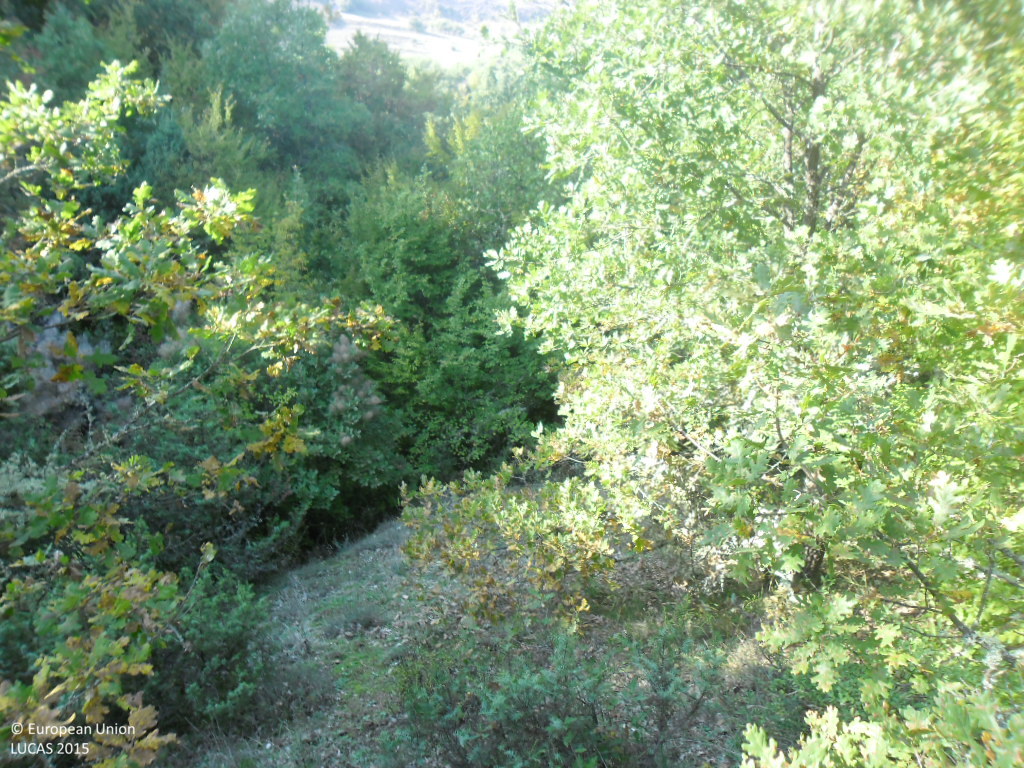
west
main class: Woodland
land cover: Broadleaved woodland
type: hemiboreal forest and nemoral coniferous forest and mixed broadleaved-coniferous forest
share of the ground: > 75 %
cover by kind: broadleaved forest trees 95 %, unconsolidated bare surface 5 %
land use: Forestry
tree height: > 5 m
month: October
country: BG
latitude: 41.4848
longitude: 23.4005
